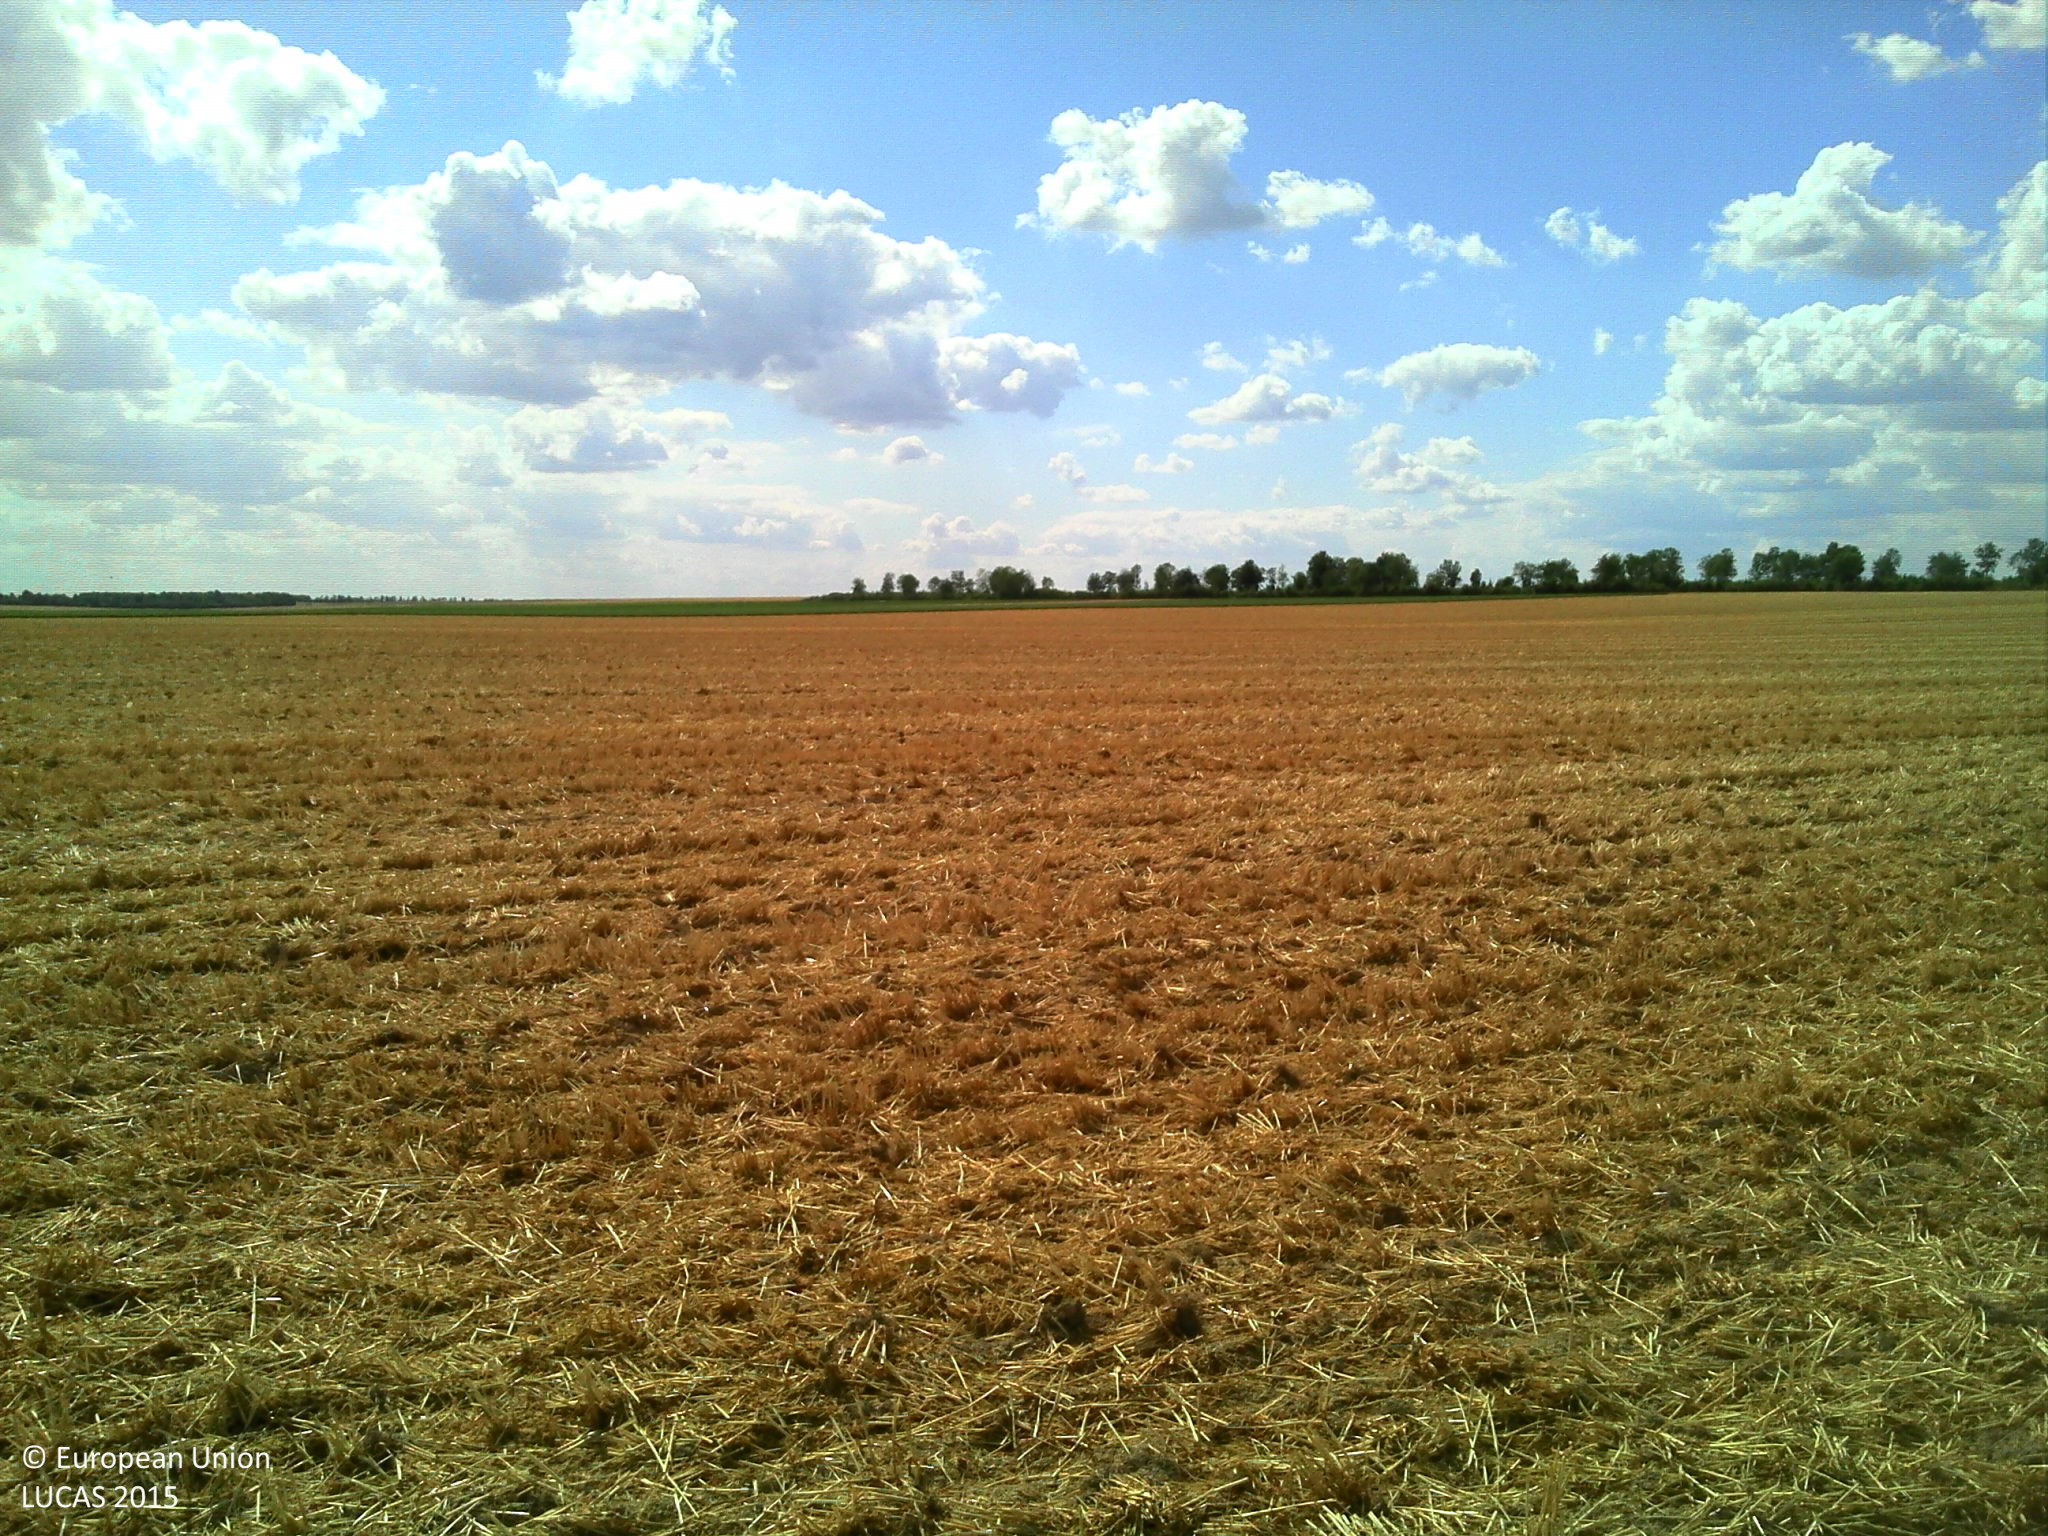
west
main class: Cropland
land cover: Common wheat
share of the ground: > 75 %
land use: Agriculture (excluding fallow land and kitchen gardens)
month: July
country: FR
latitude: 48.9184
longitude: 4.1961
